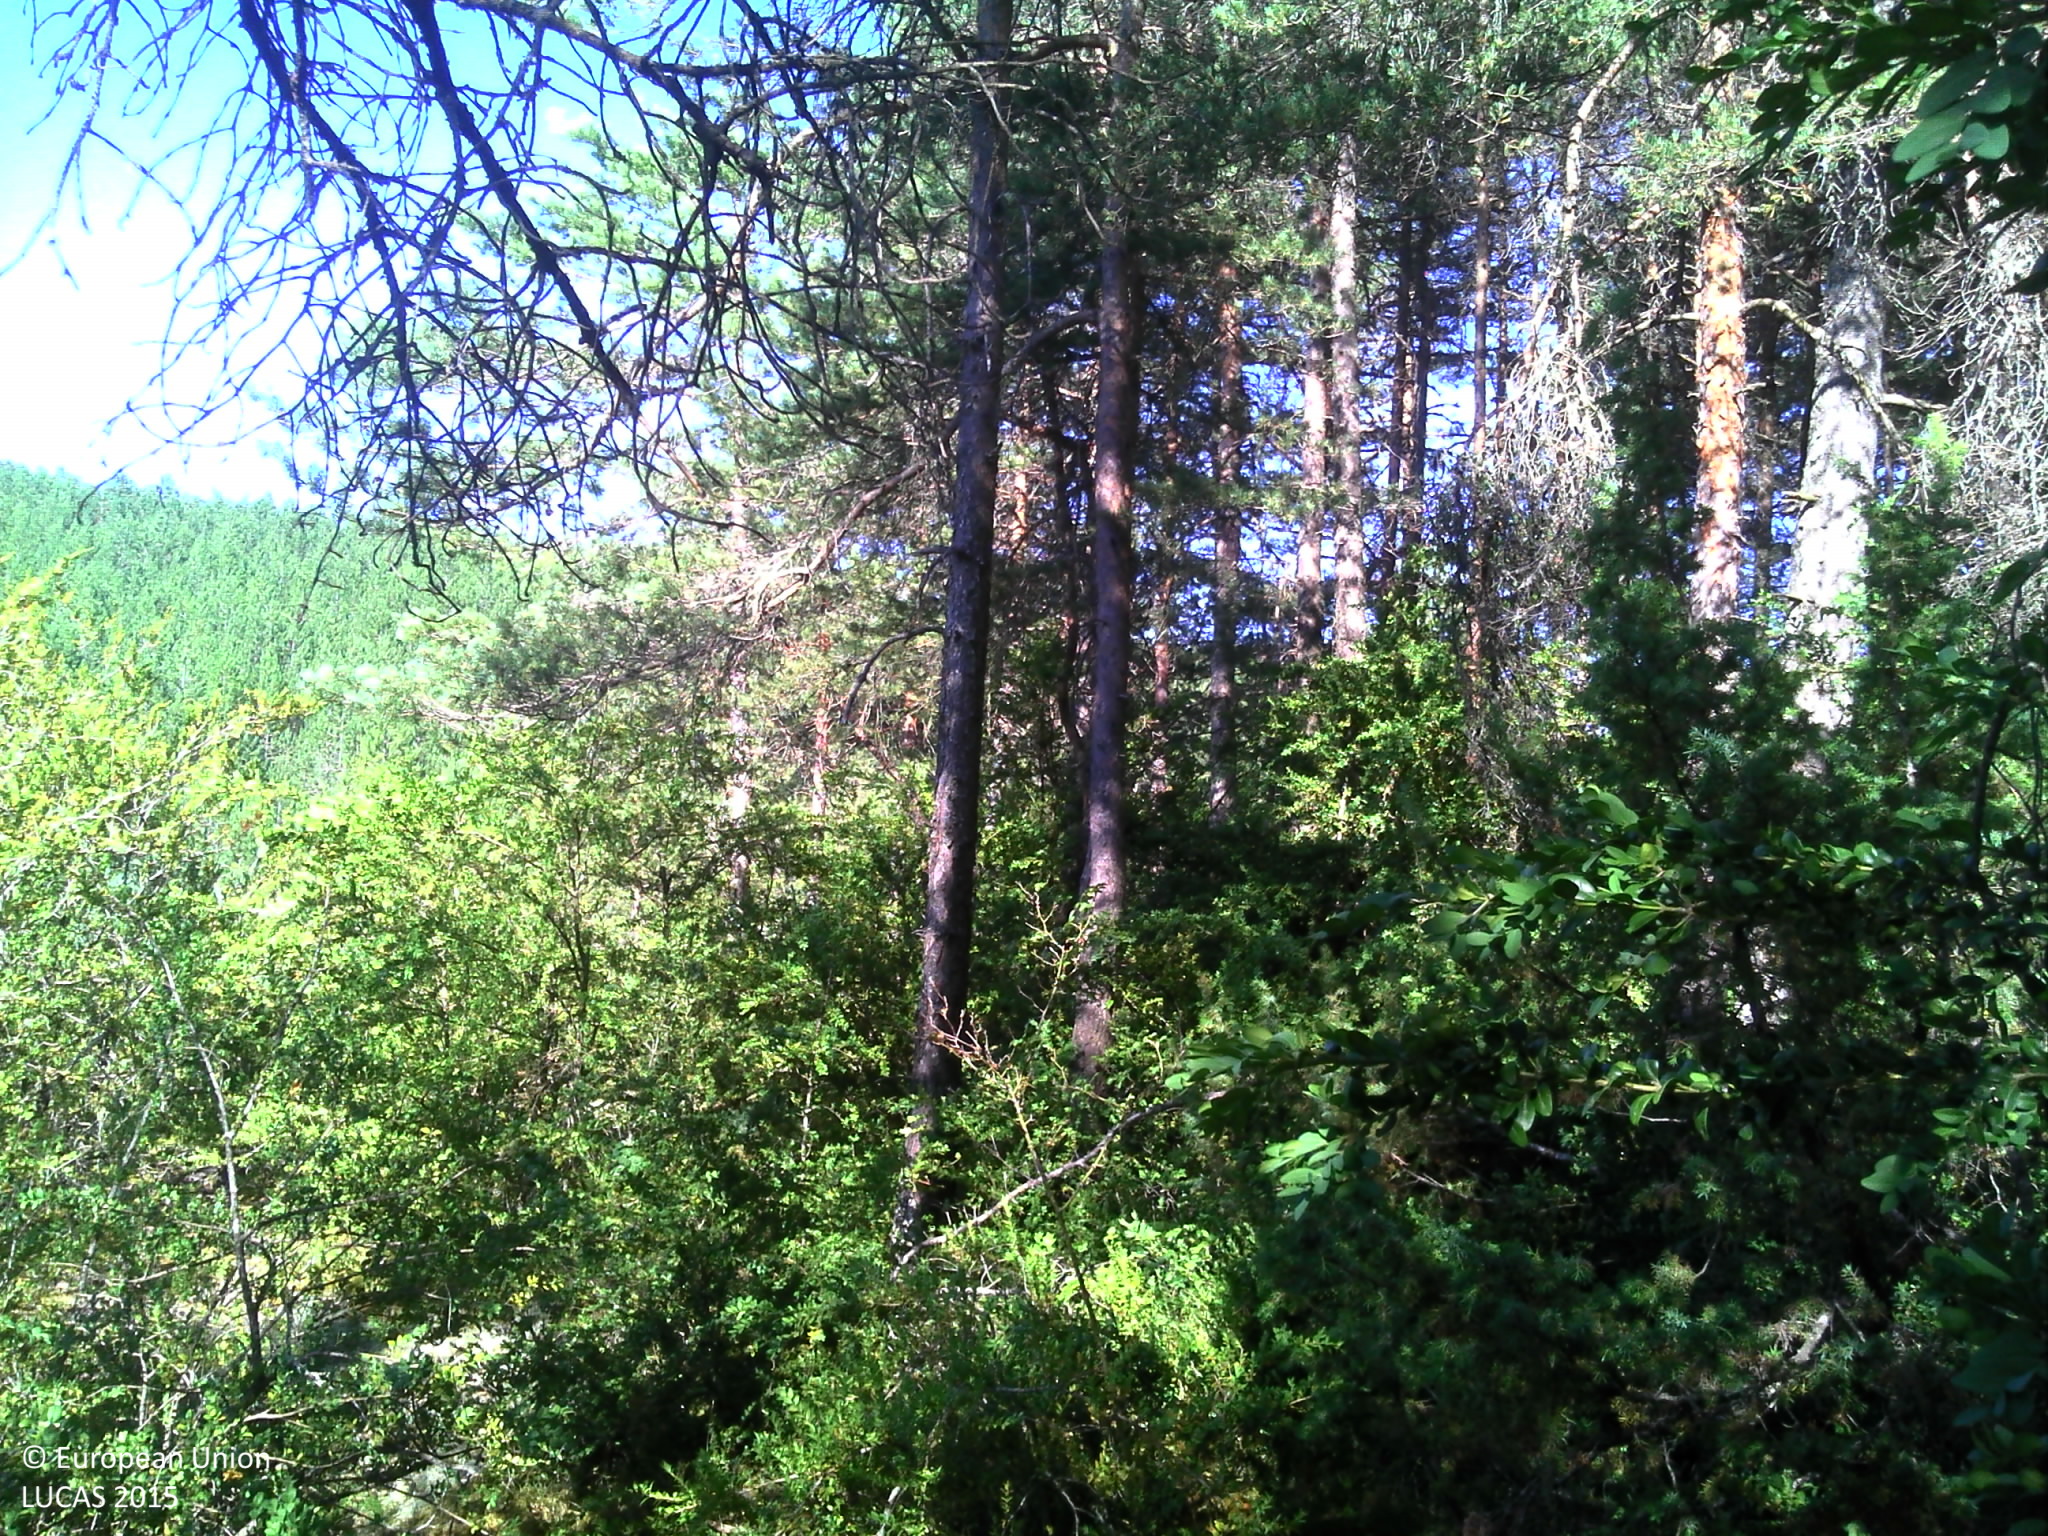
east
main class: Woodland
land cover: Pine dominated coniferous woodland
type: alpine coniferous forest
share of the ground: > 75 %
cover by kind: coniferous forest trees 75 %, shrubs 10 %, herbaceous plants 10 %, broadleaved forest trees 5 %
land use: Forestry
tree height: > 5 m
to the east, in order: Pine dominated coniferous woodland; Shrubland with sparse tree cover; Pine dominated coniferous woodland
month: July
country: FR
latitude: 44.3670
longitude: 3.2667
